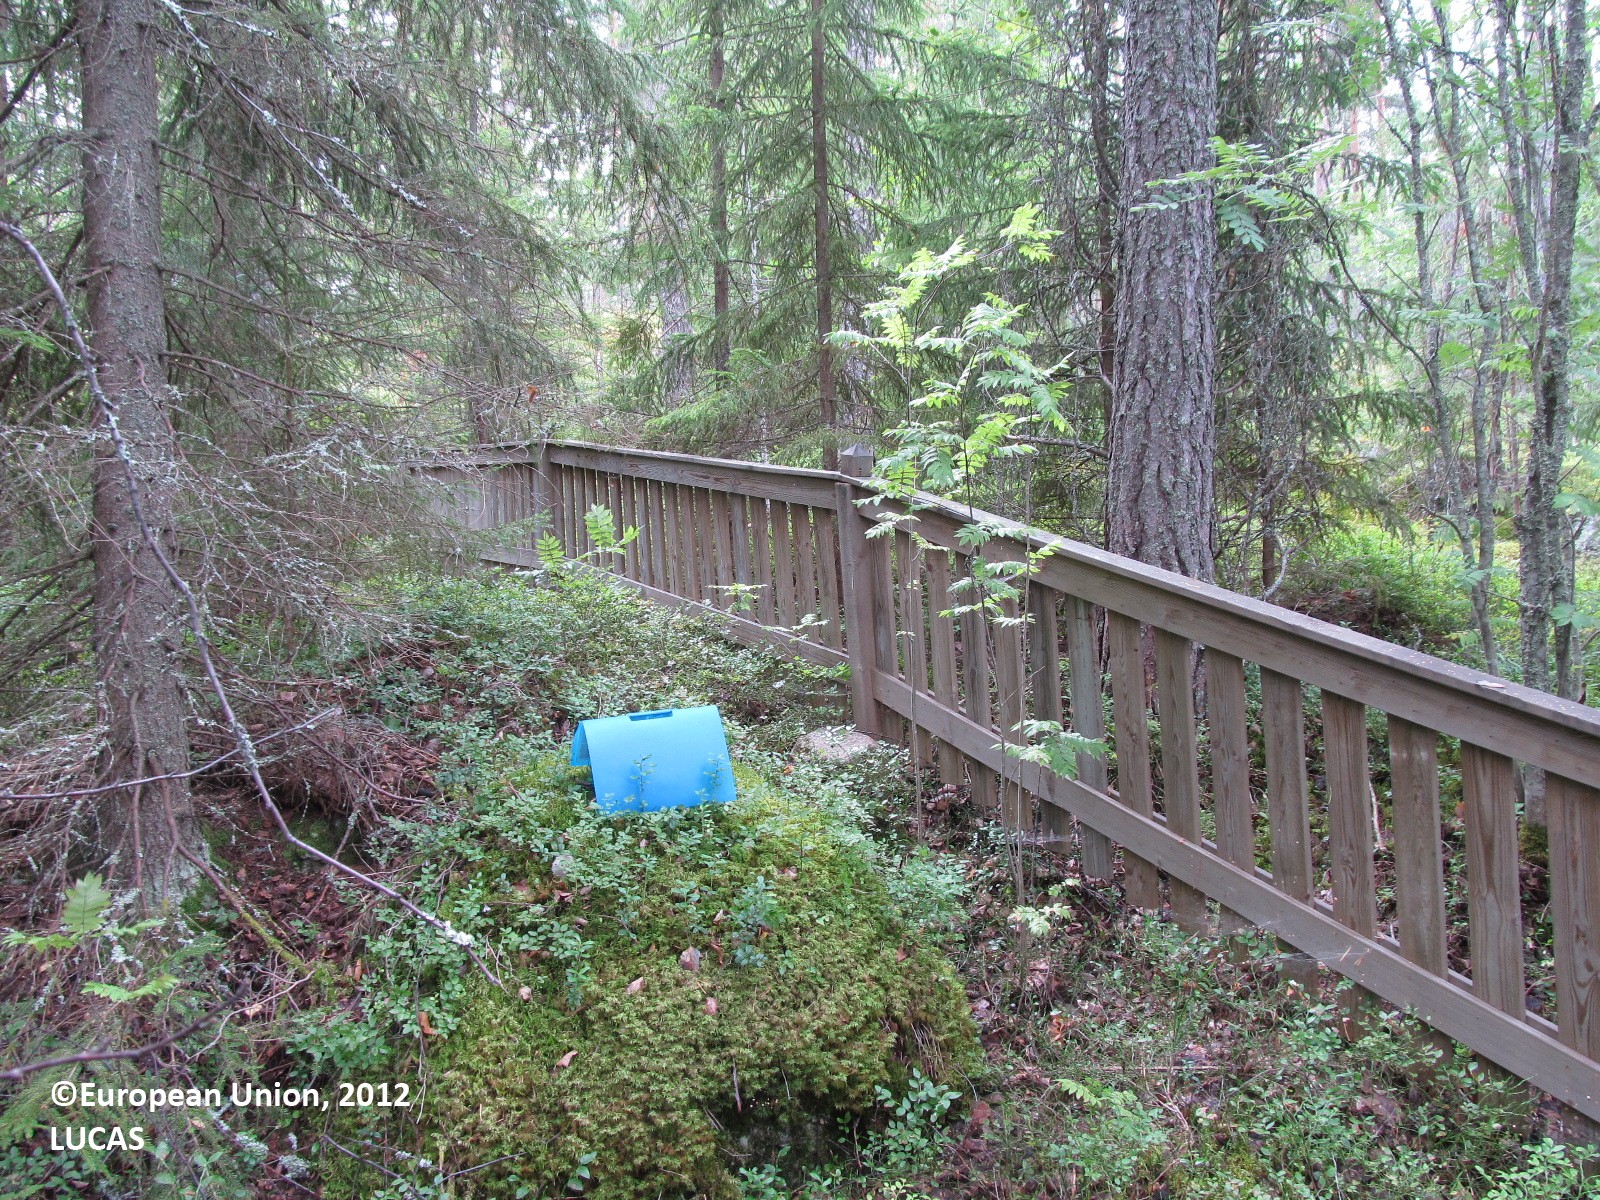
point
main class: Woodland
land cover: Spruce dominated mixed woodland
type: boreal forest
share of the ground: 25 - 50 %
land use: Forestry
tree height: > 5 m
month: August
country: FI
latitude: 62.1780
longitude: 28.0306
